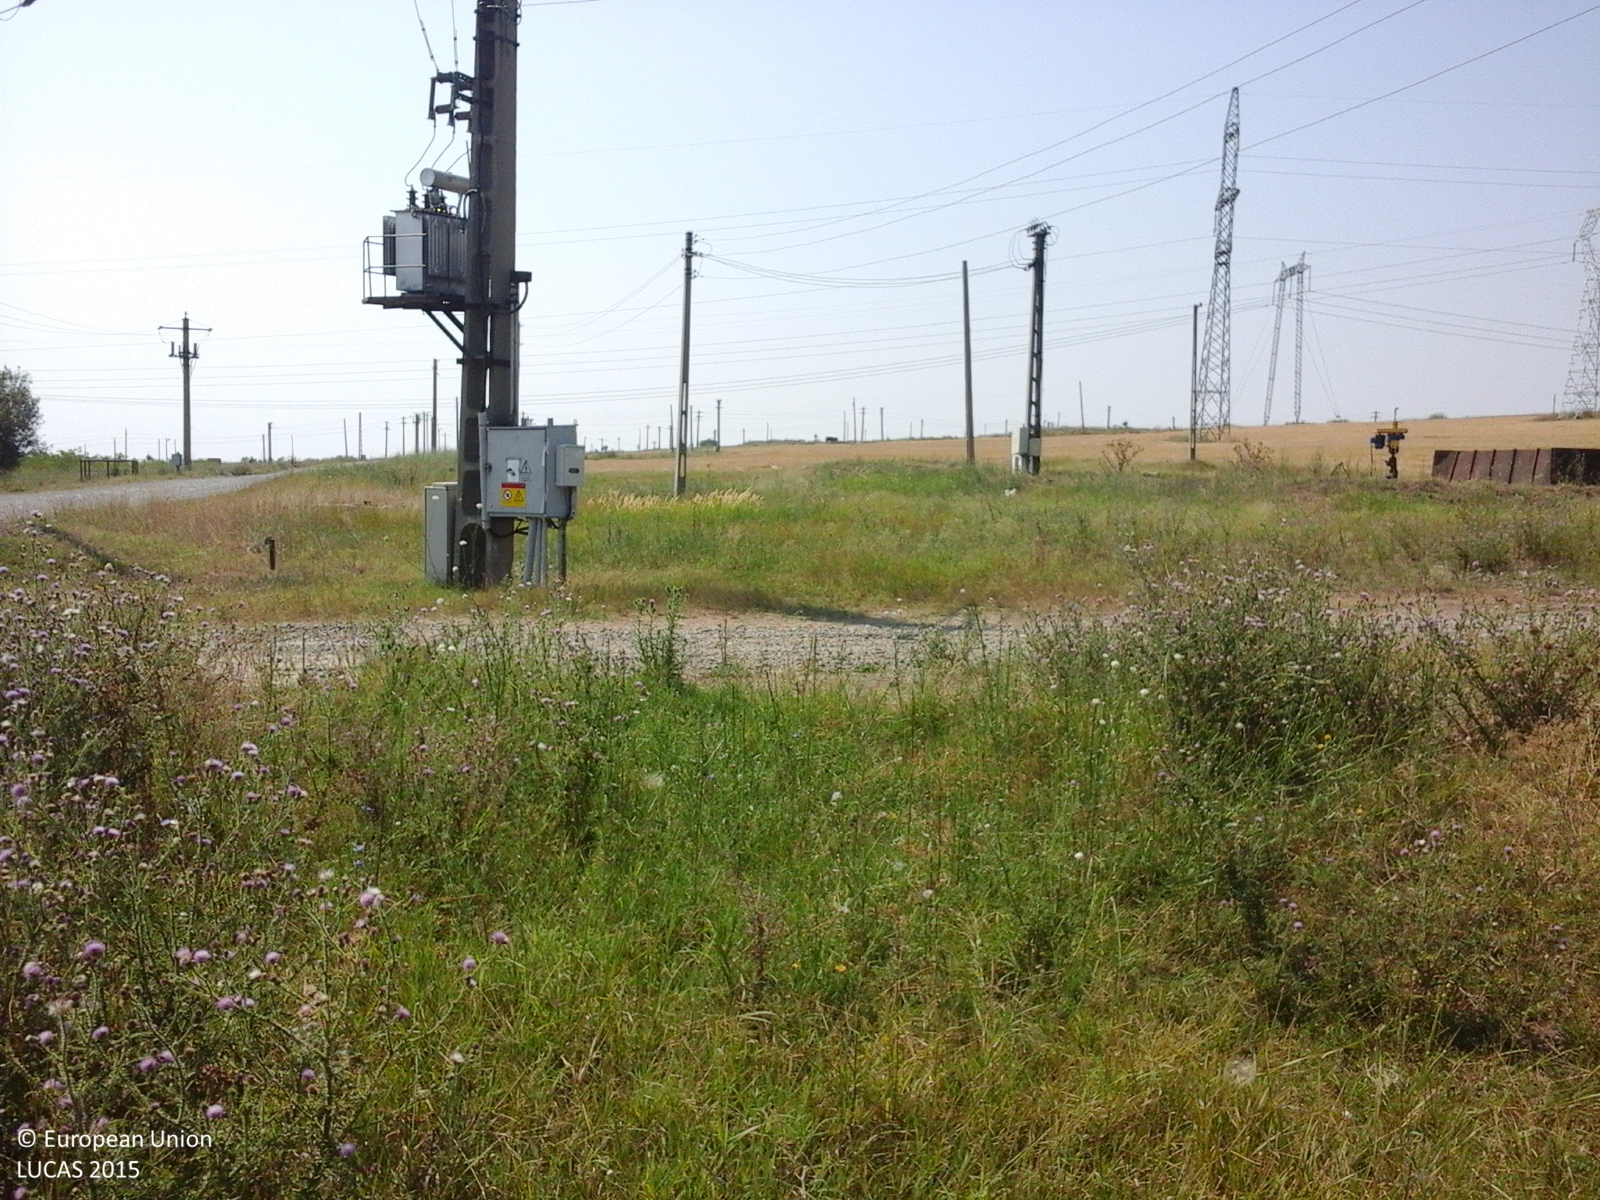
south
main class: Grassland
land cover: Grassland without tree/shrub cover
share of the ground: > 75 %
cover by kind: herbaceous plants 100 %
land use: Agriculture (excluding fallow land and kitchen gardens)
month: July
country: RO
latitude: 45.5213
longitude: 27.8180
